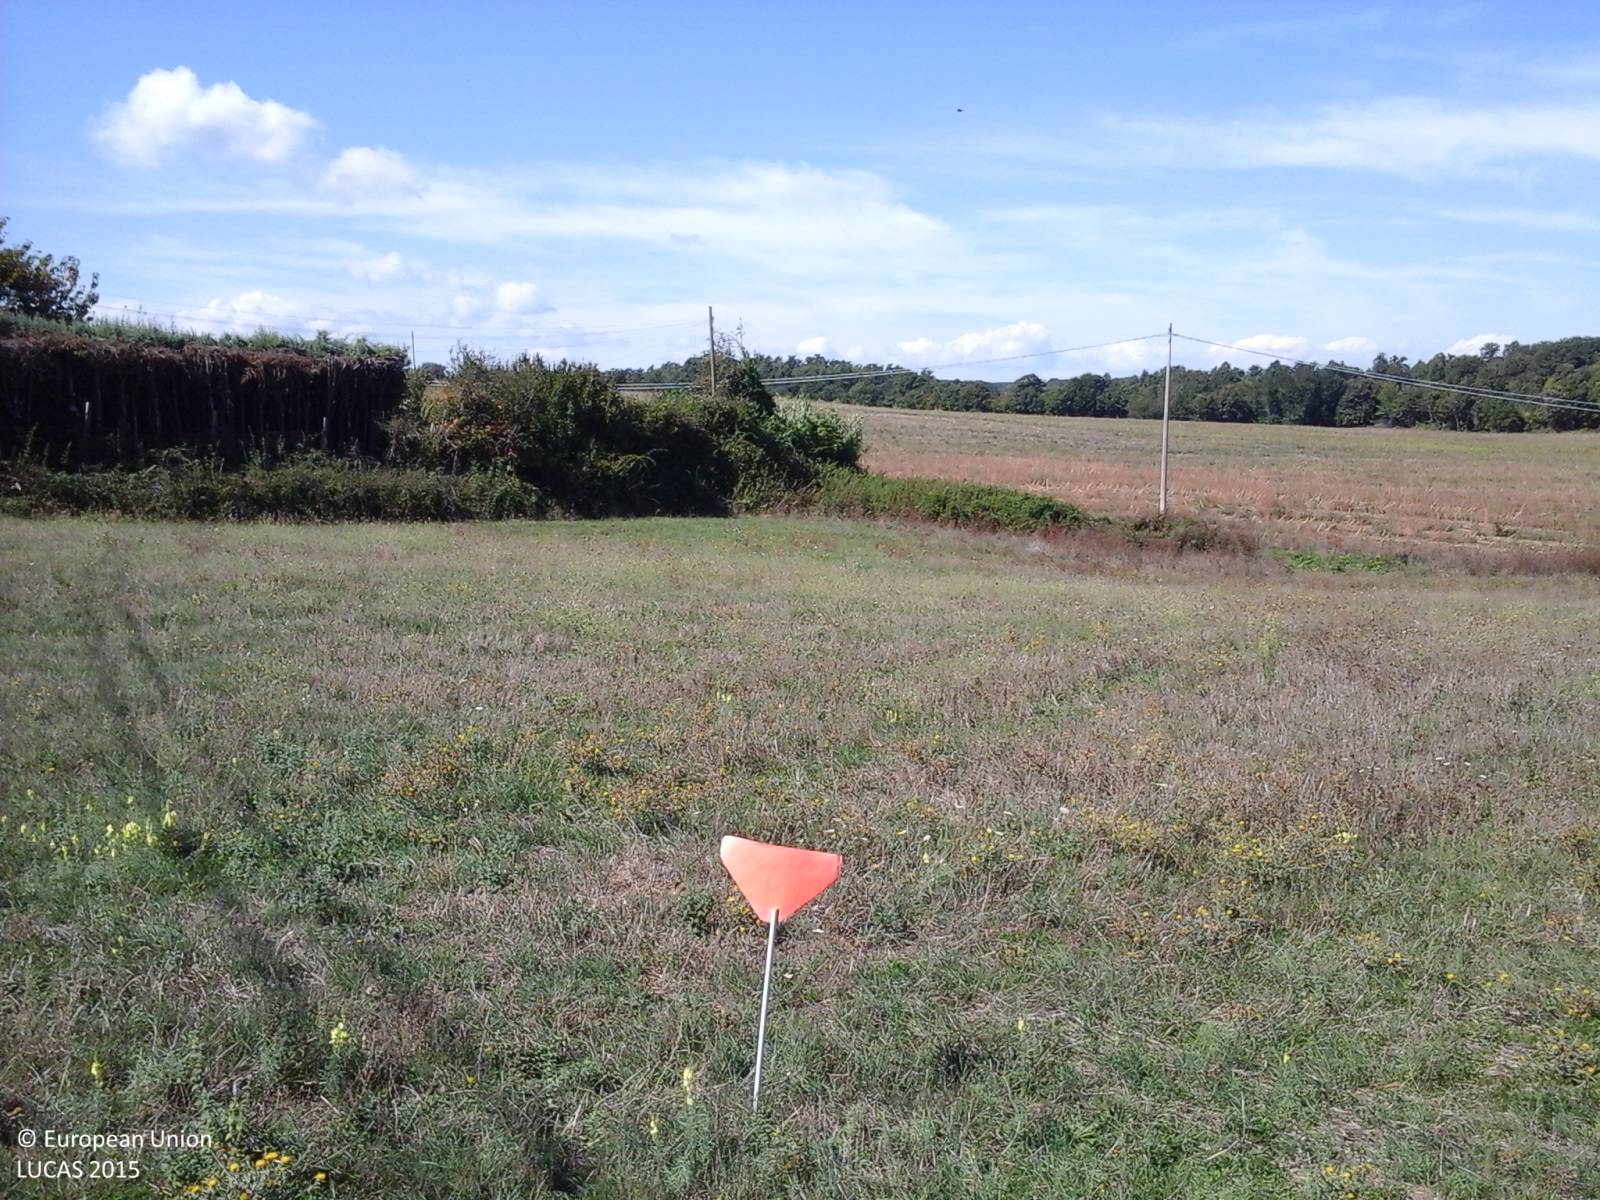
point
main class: Grassland
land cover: Grassland without tree/shrub cover
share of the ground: > 75 %
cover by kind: herbaceous plants 100 %
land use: Agriculture (excluding fallow land and kitchen gardens)
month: September
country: IT
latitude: 42.6874
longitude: 12.0560
